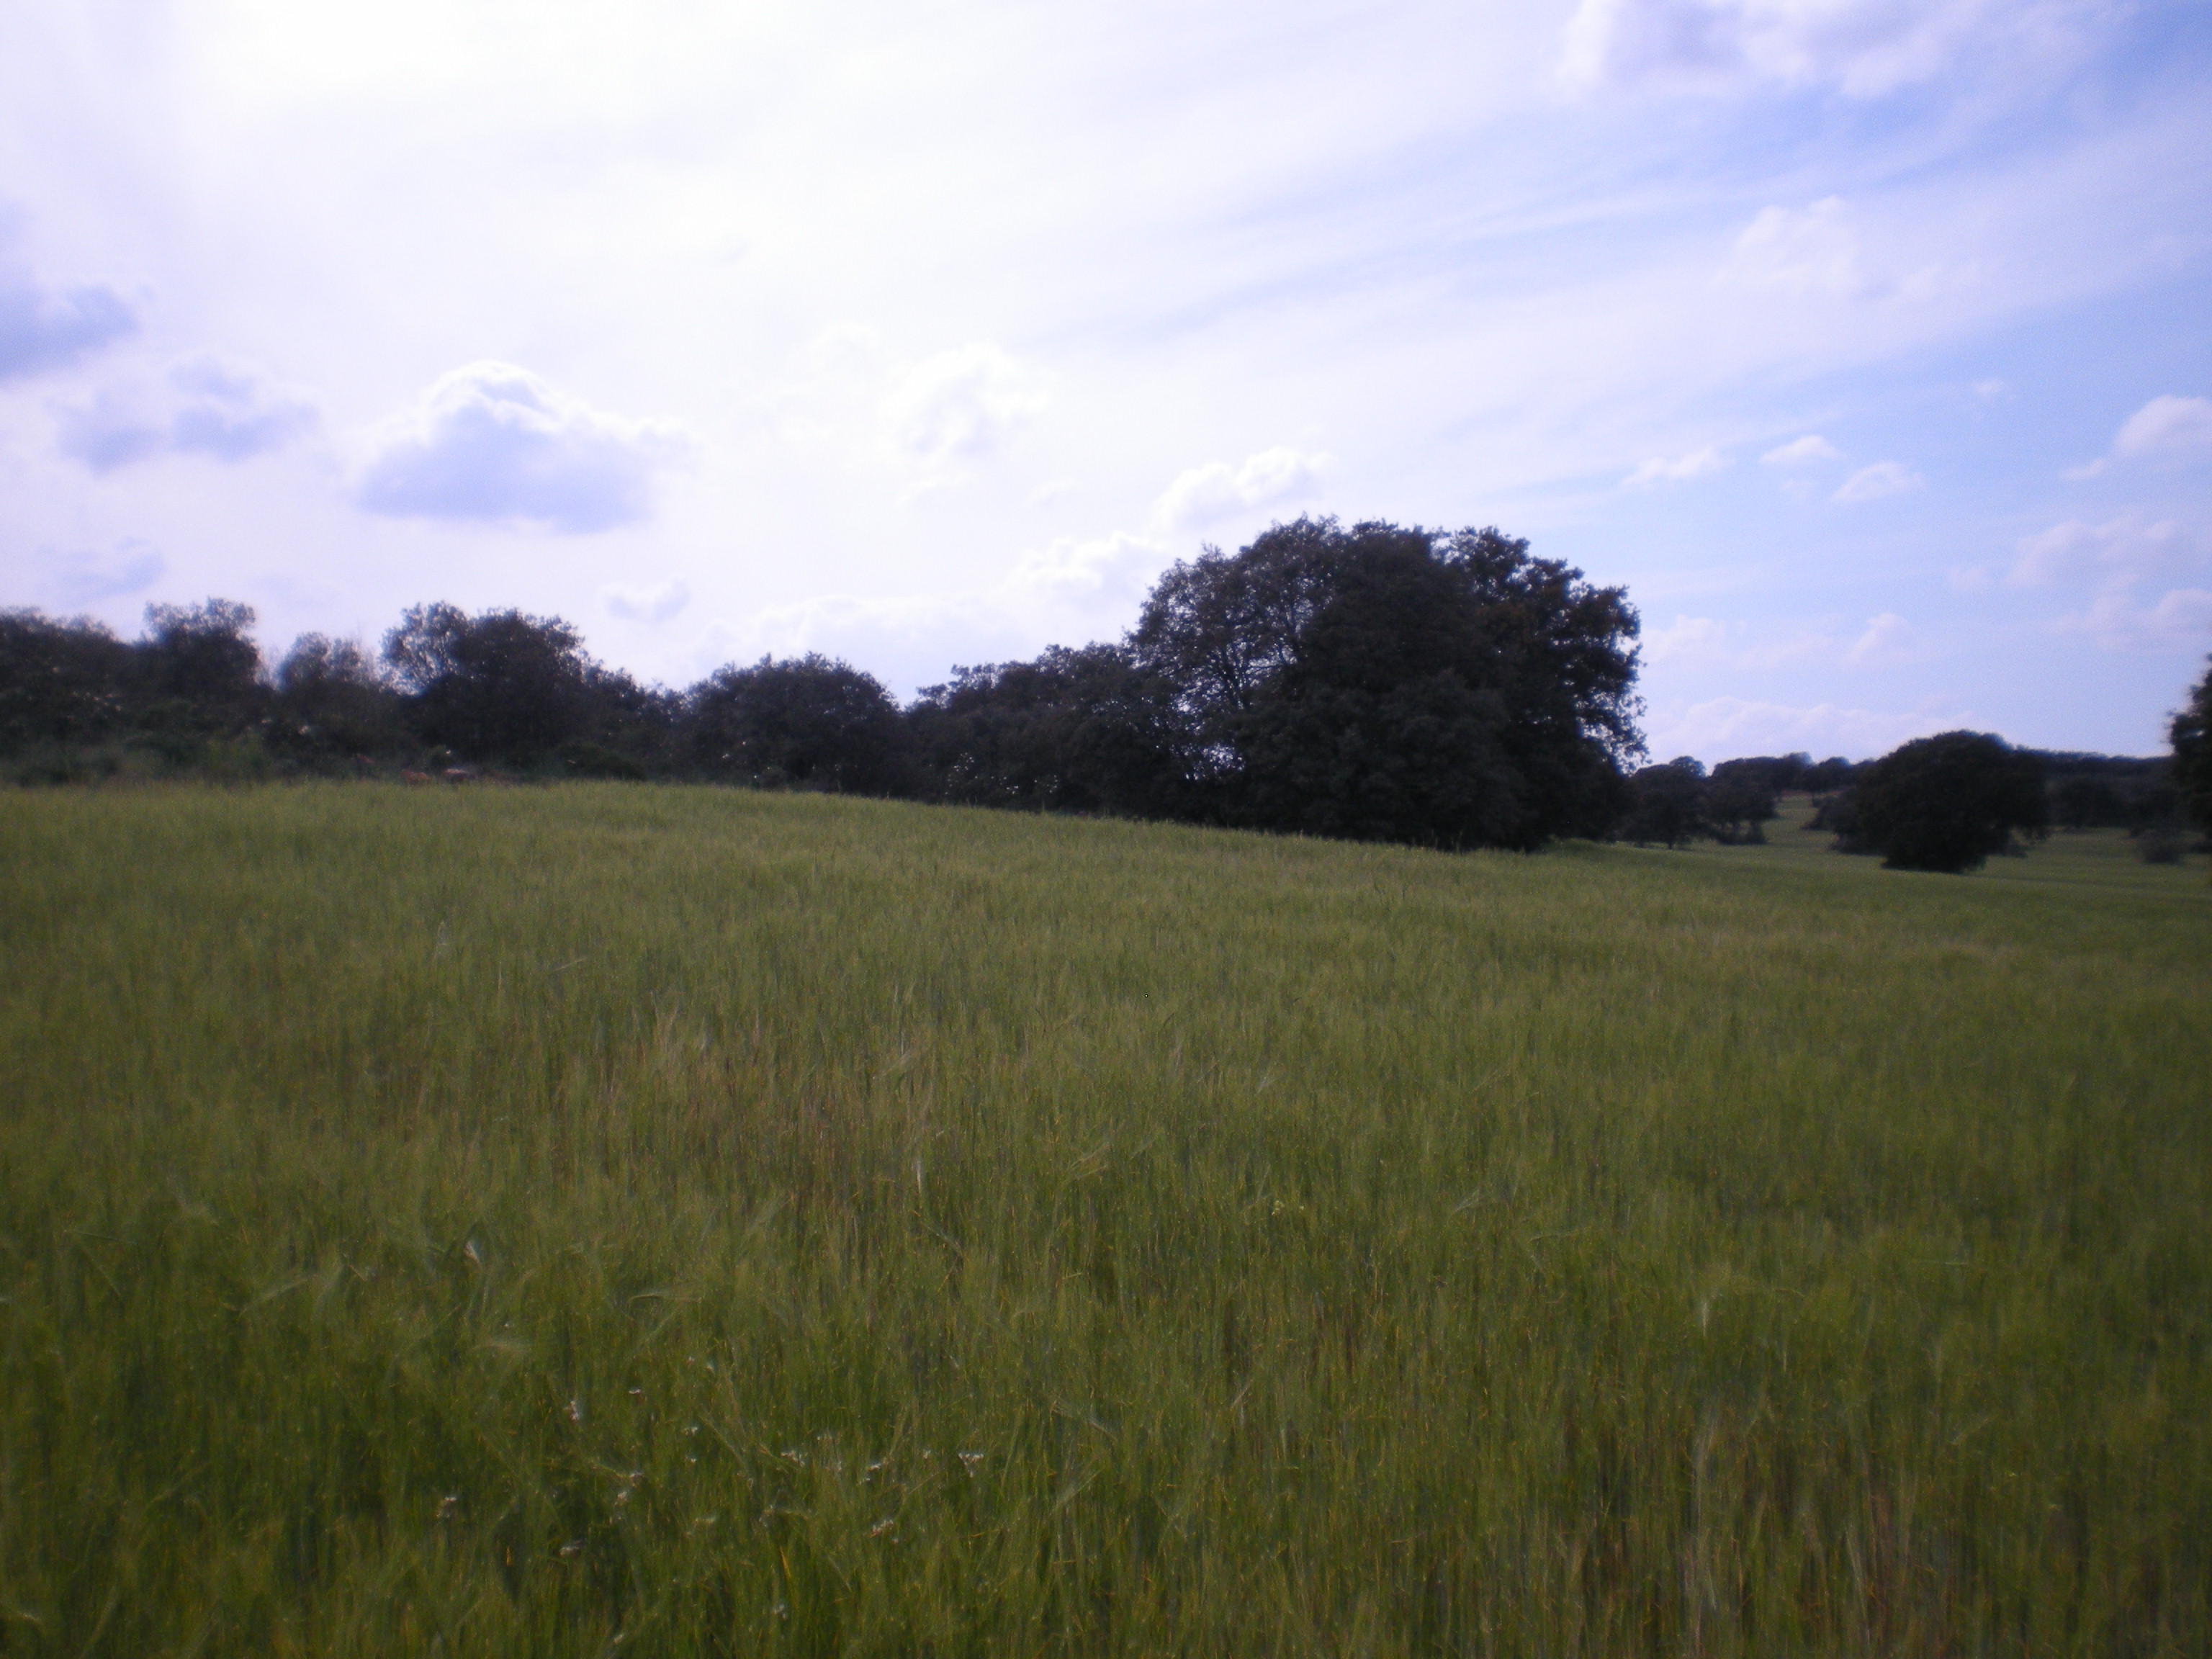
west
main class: Cropland
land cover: Barley
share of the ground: > 75 %
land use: Agriculture (excluding fallow land and kitchen gardens)
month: April
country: ES
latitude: 38.9056
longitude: -3.5178
